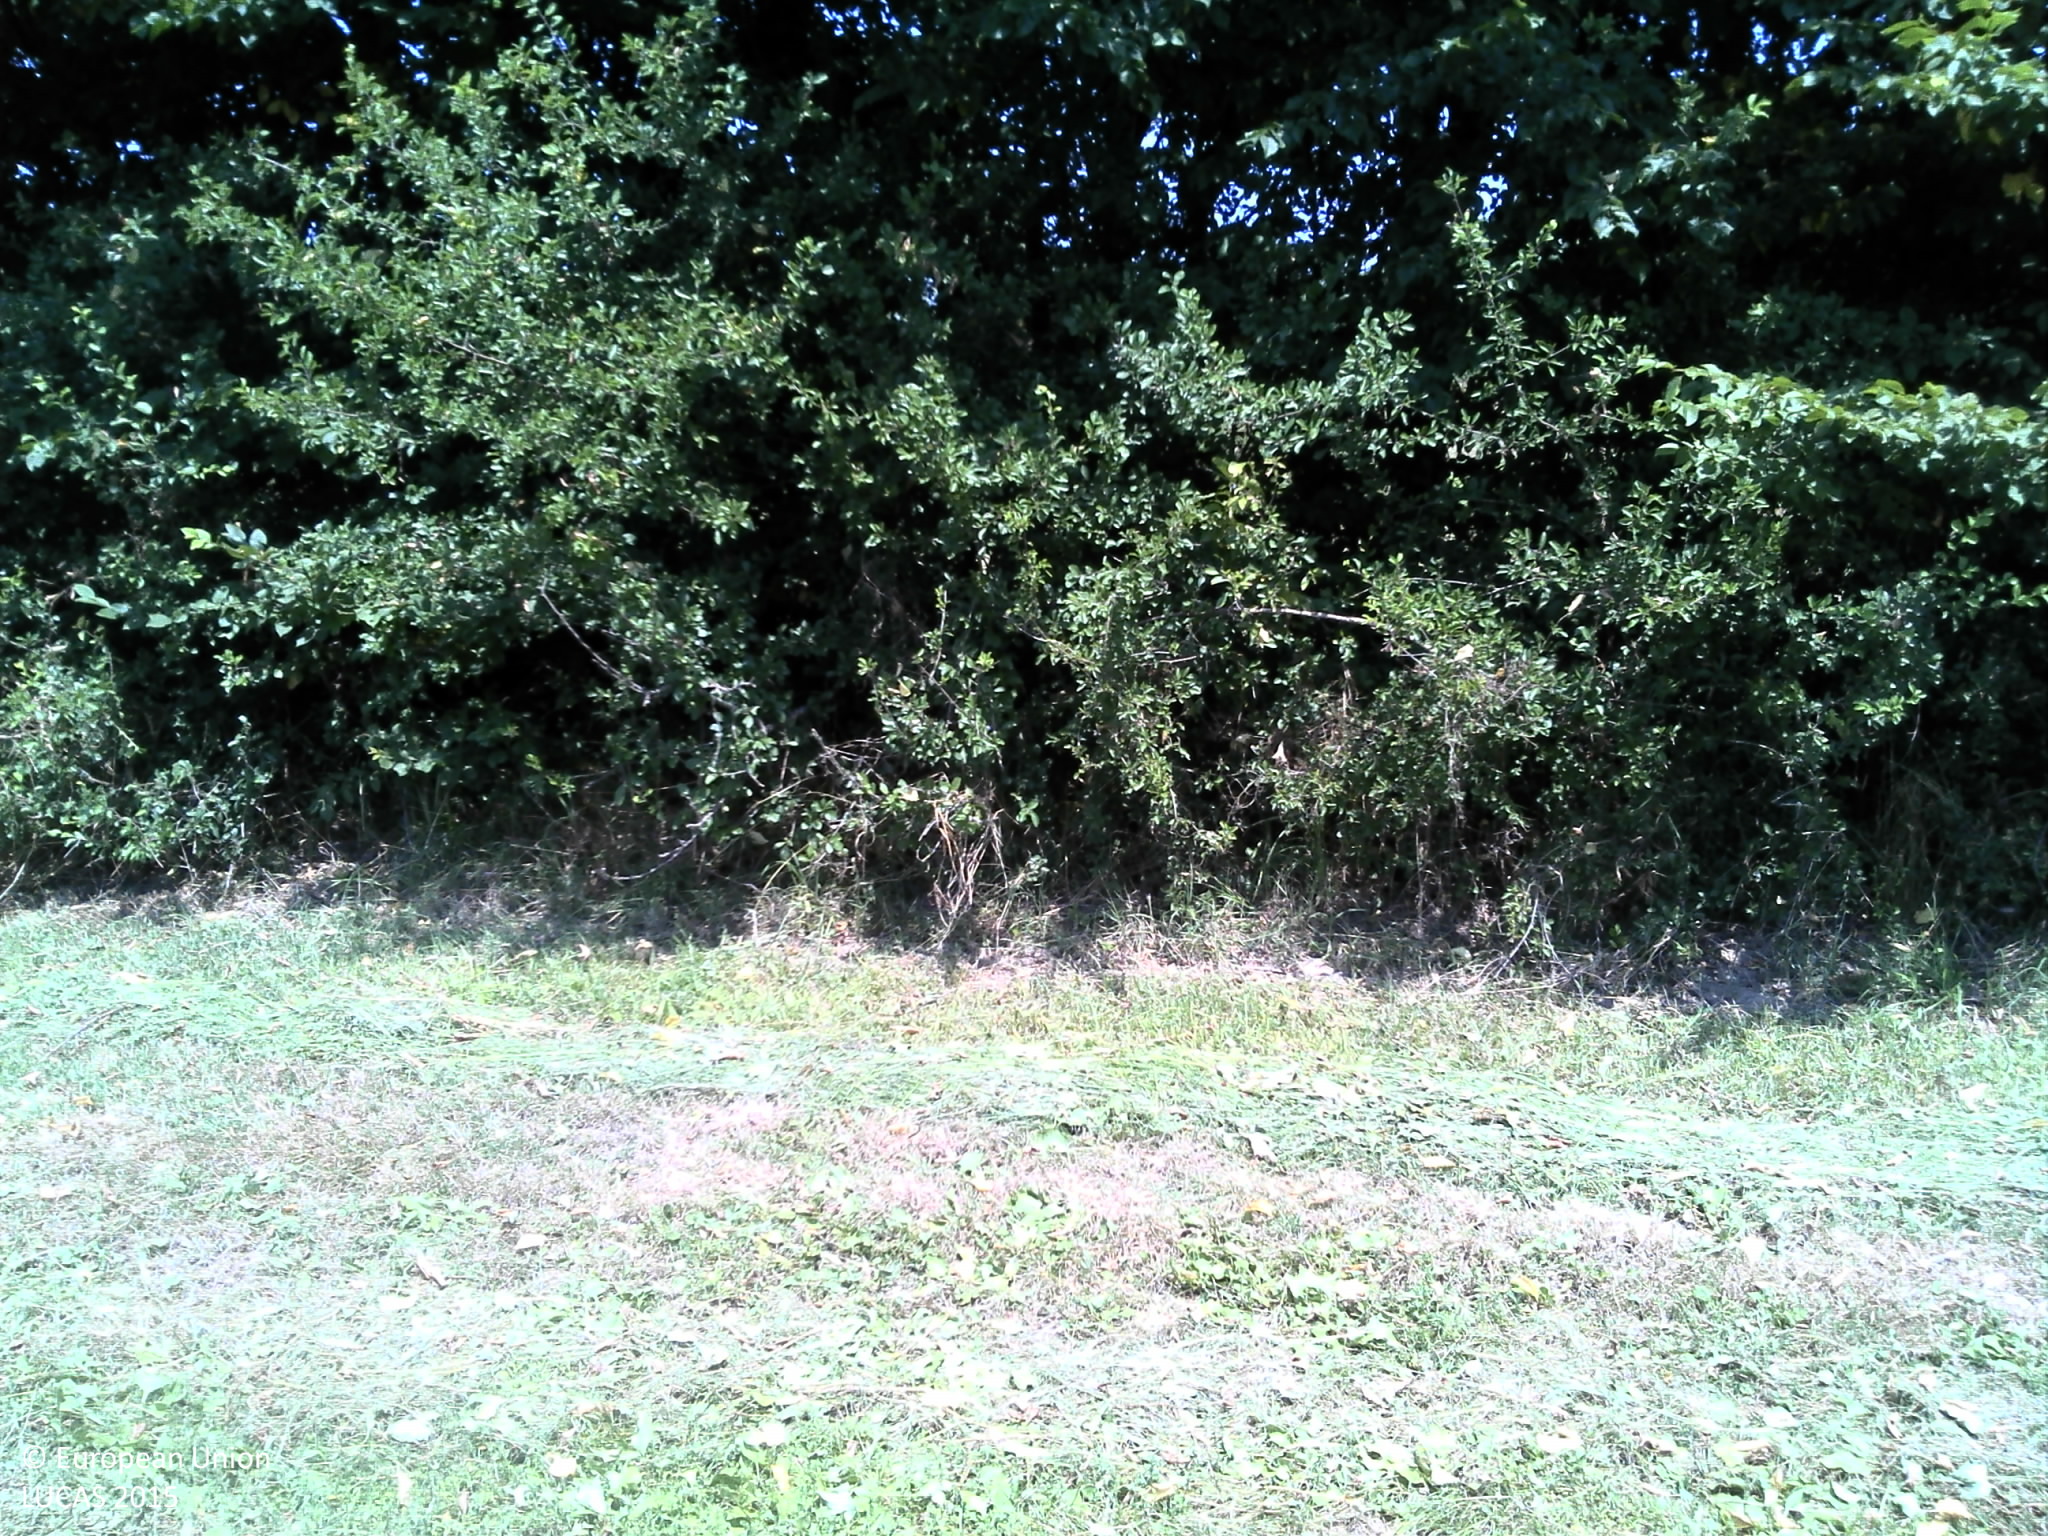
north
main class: Cropland
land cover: Clovers
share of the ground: > 75 %
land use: Agriculture (excluding fallow land and kitchen gardens)
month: July
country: HR
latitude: 45.6996
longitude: 16.8194
